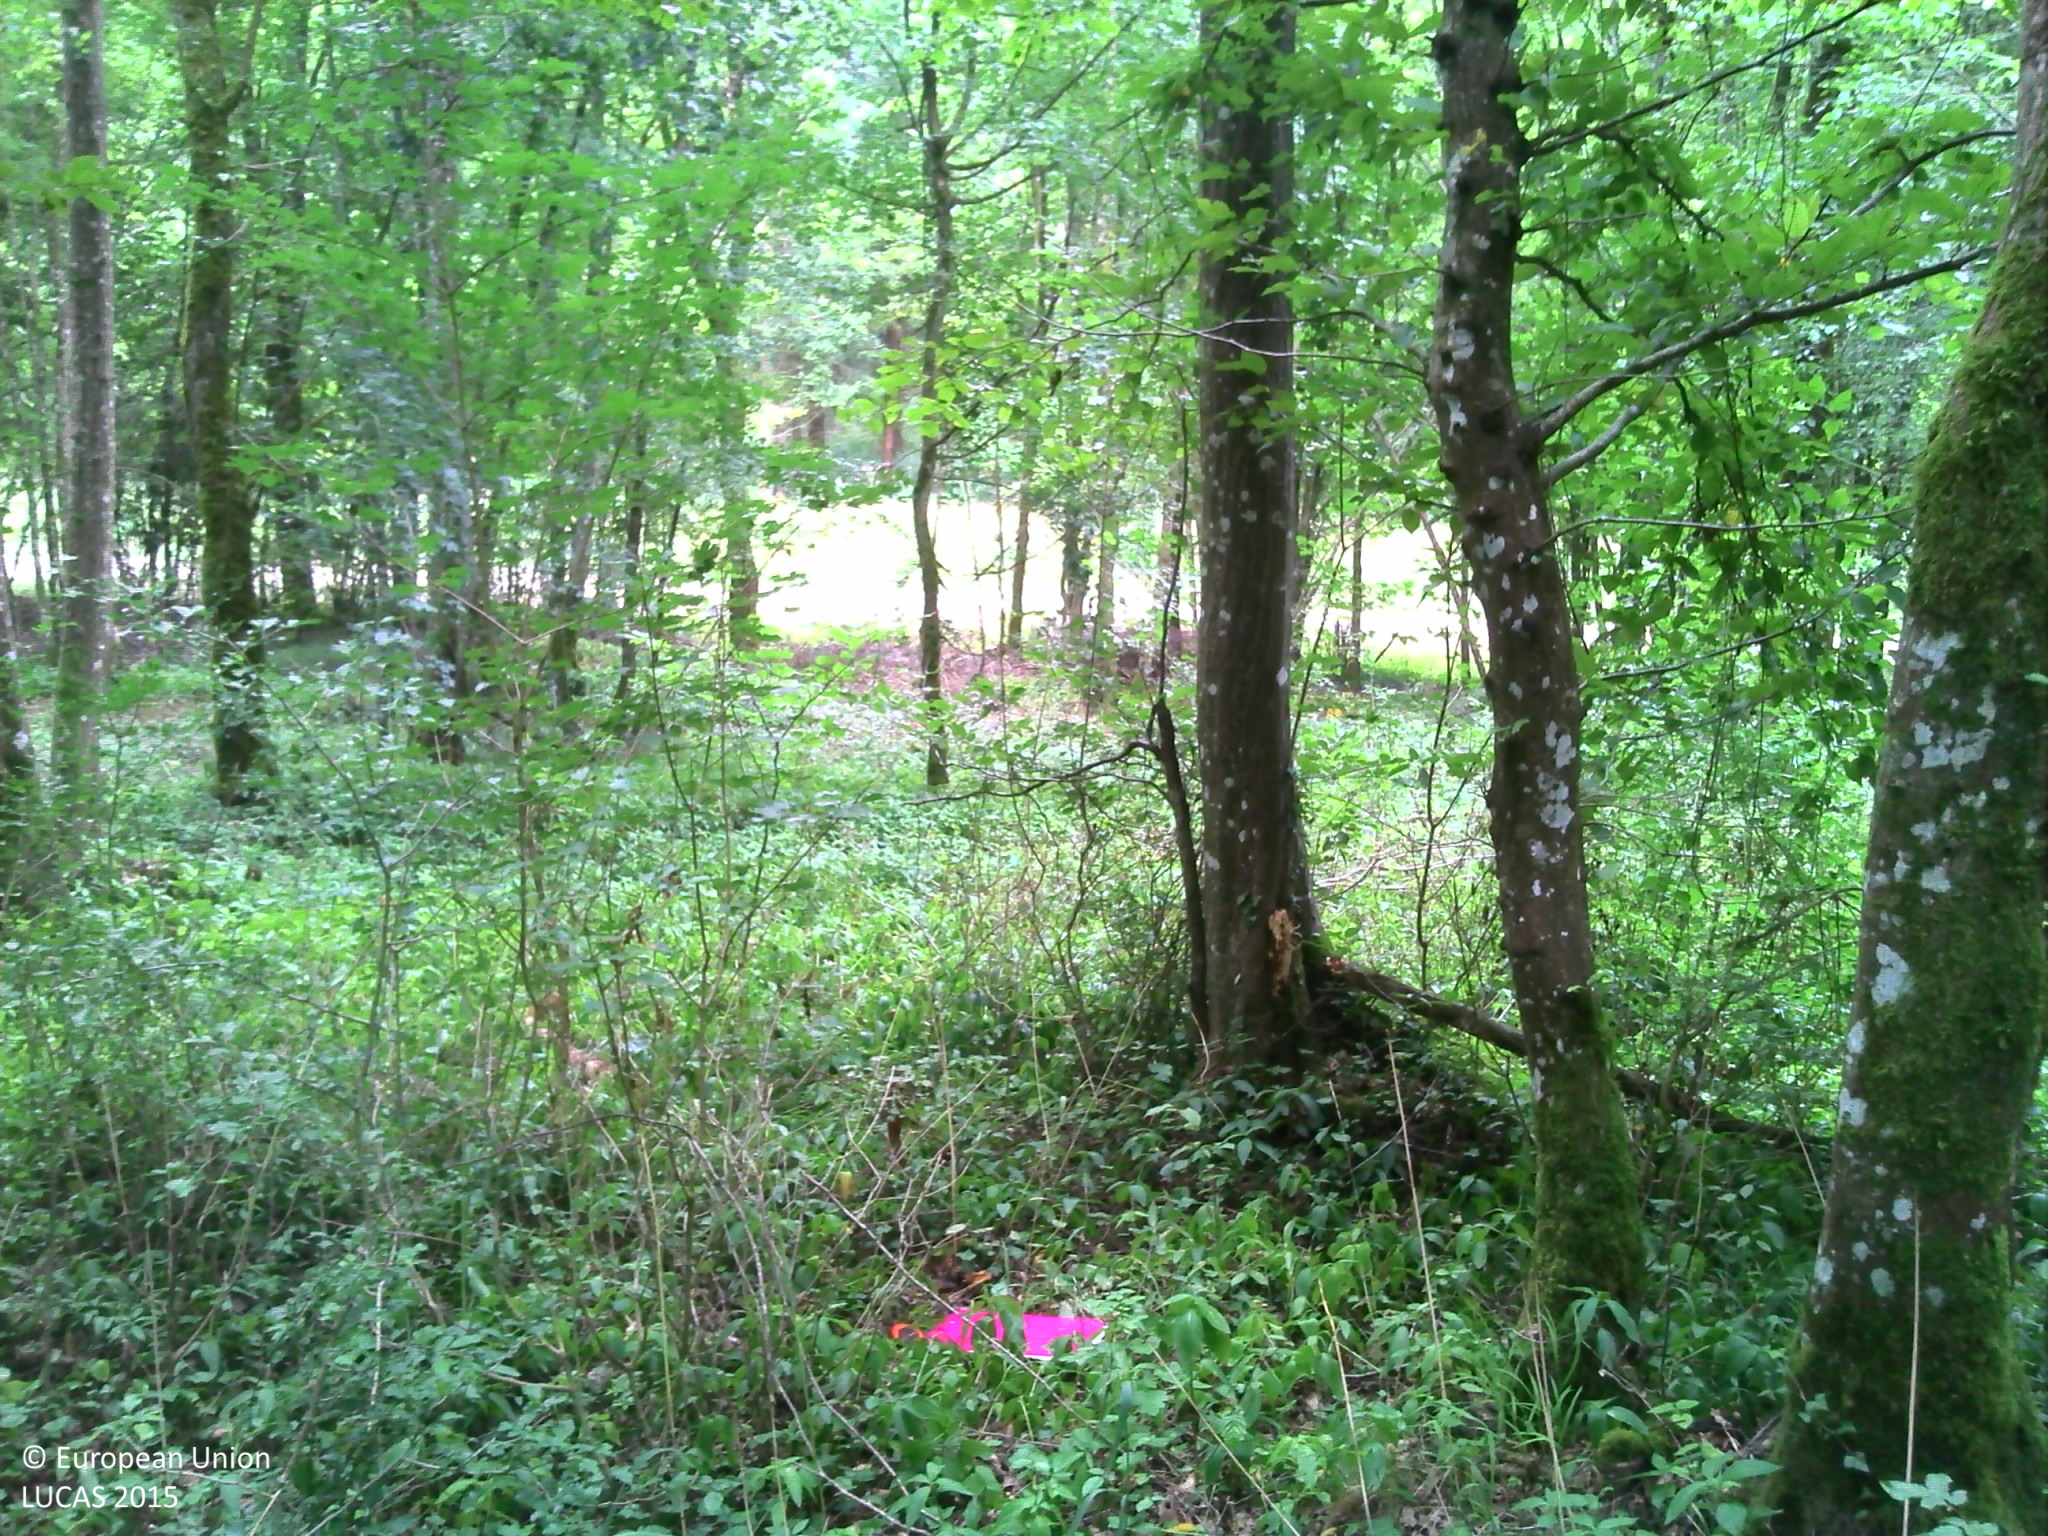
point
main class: Woodland
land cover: Broadleaved woodland
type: mesophytic deciduous forest
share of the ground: > 75 %
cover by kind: broadleaved forest trees 95 %, herbaceous plants 5 %
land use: Forestry
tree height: > 5 m
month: July
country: FR
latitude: 49.1805
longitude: 5.1554
